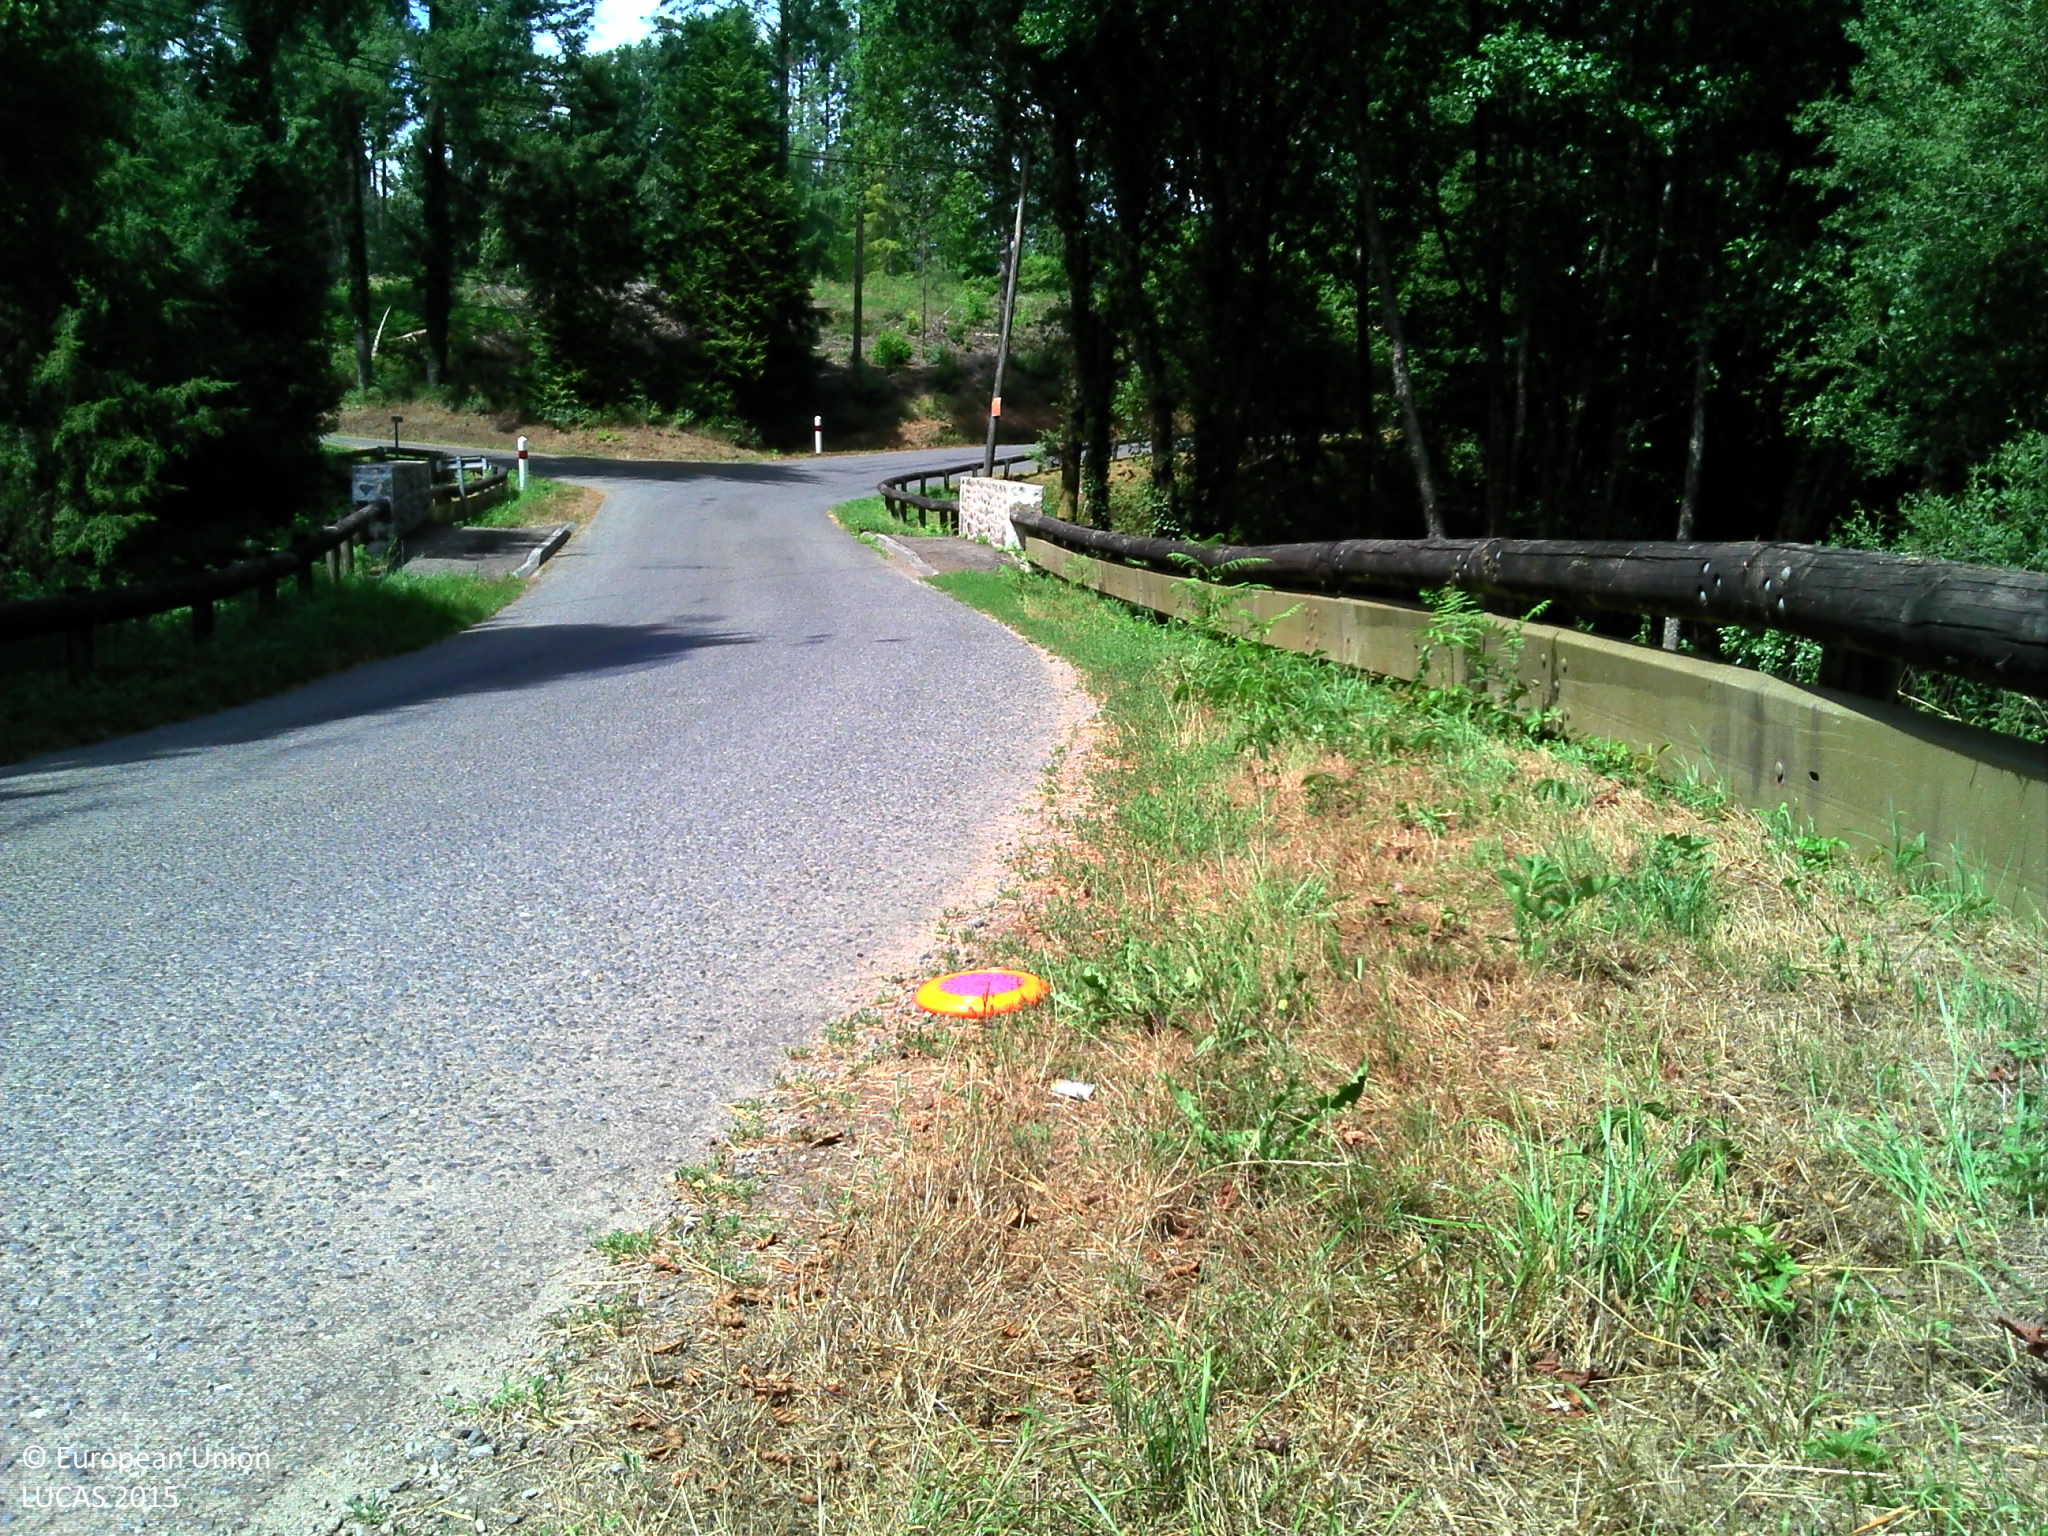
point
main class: Grassland
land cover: Spontaneously vegetated surfaces
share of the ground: > 75 %
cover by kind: herbaceous plants 95 %
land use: Semi-natural and natural areas not in use
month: July
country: FR
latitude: 45.7865
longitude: 1.6193
